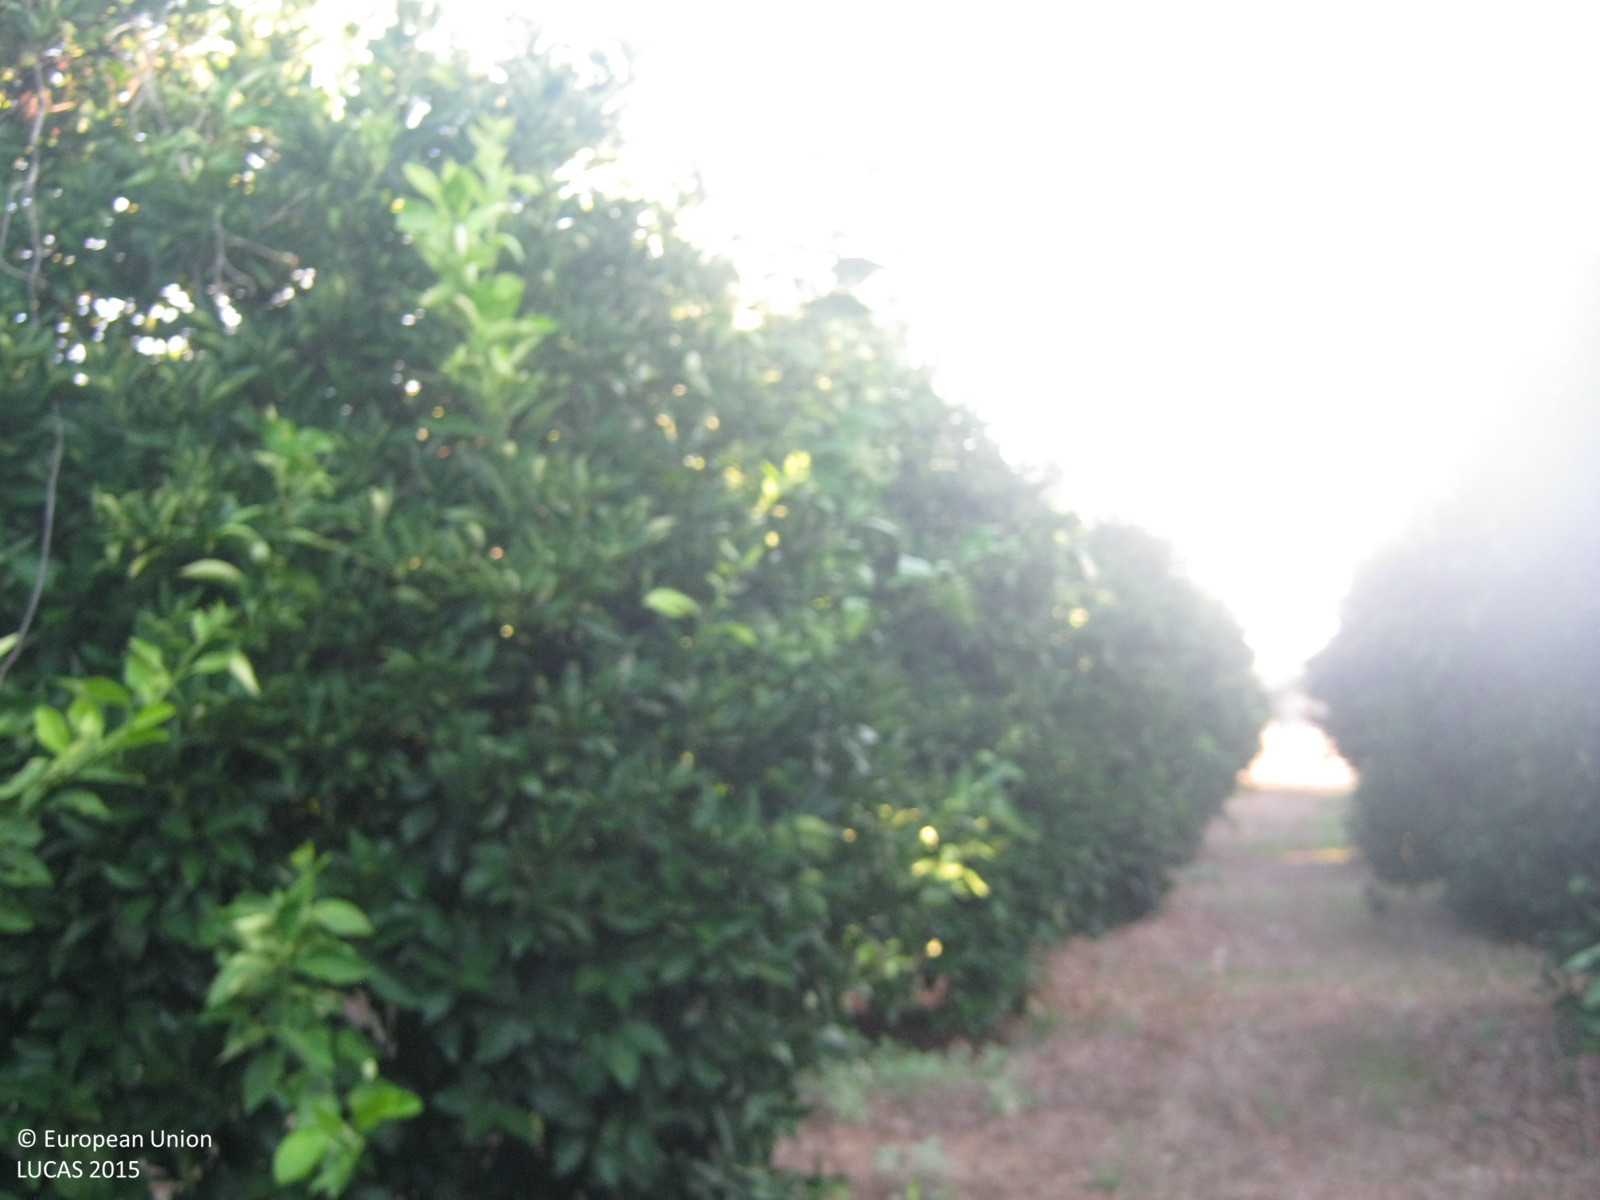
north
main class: Cropland
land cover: Oranges
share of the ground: > 75 %
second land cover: Spontaneously vegetated surfaces
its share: 25 - 50 %
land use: Agriculture (excluding fallow land and kitchen gardens)
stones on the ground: < 10 %
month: October
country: GR
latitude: 37.6149
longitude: 22.7793
